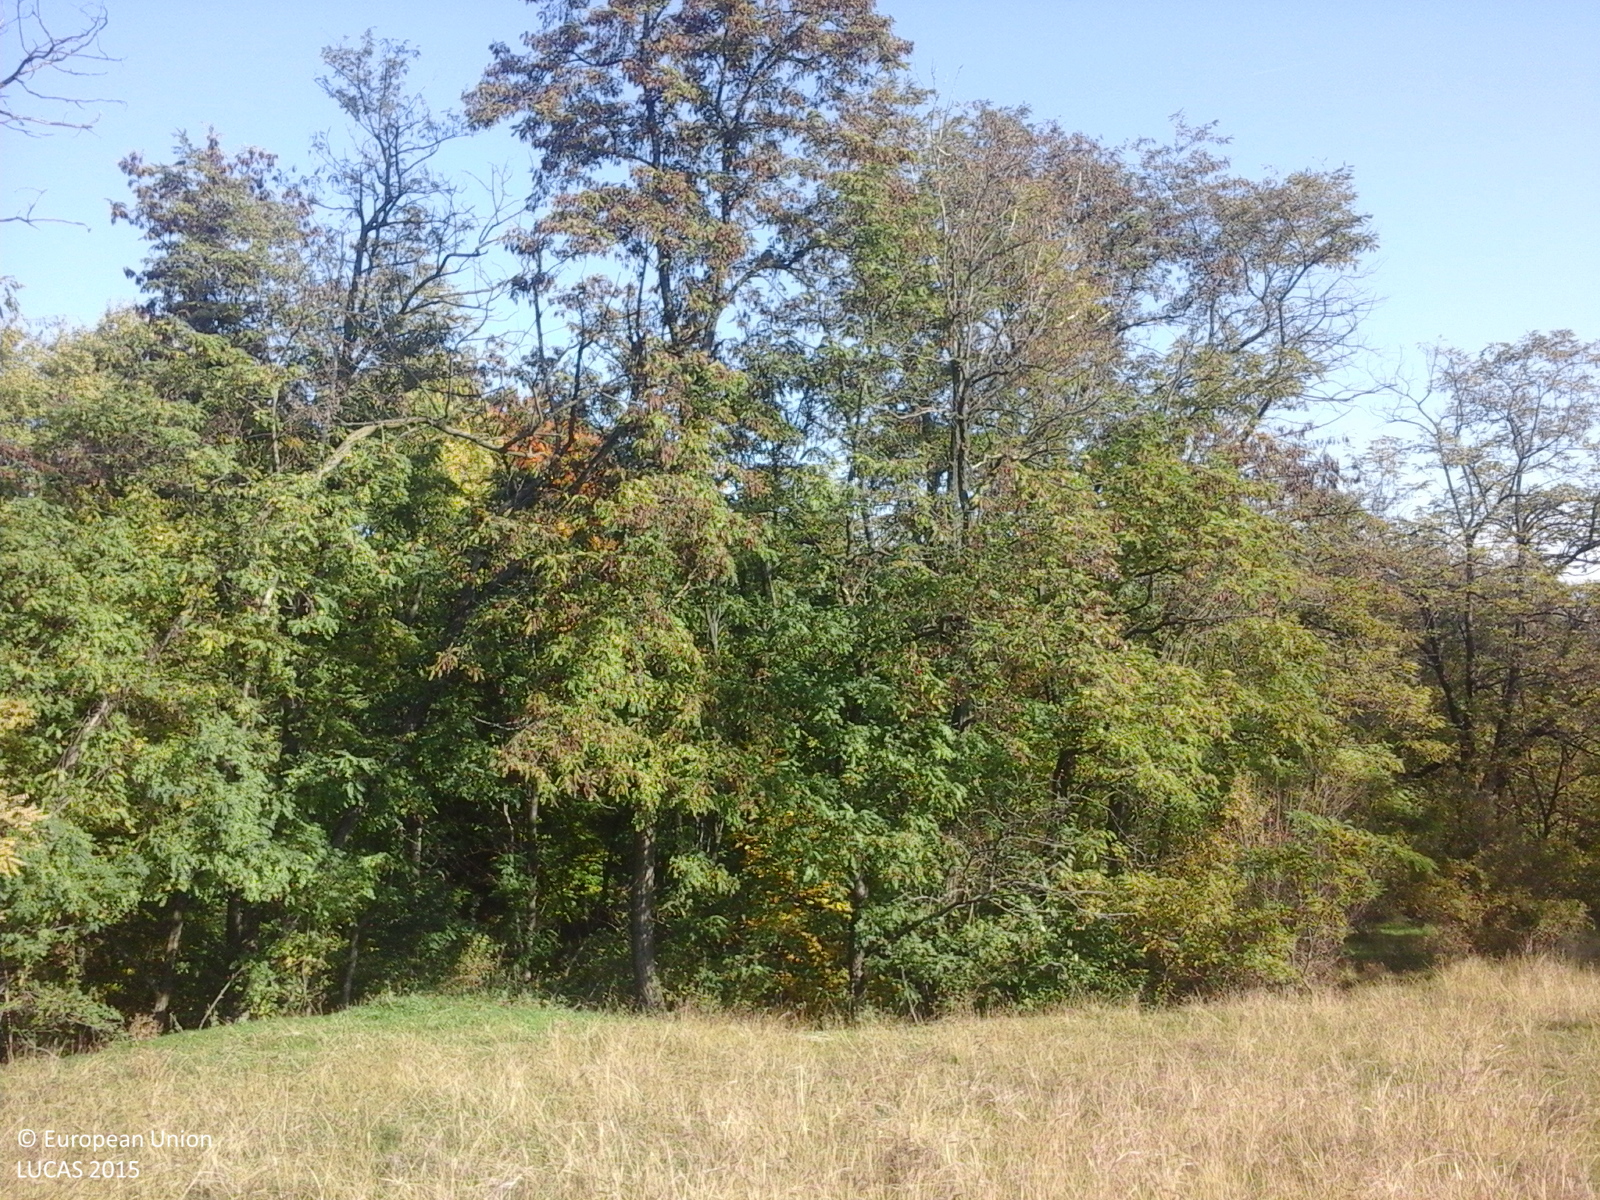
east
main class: Grassland
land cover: Grassland without tree/shrub cover
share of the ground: > 75 %
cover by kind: herbaceous plants 100 %
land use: Agriculture (excluding fallow land and kitchen gardens)
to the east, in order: Grassland without tree/shrub cover; Broadleaved woodland; Vineyards; Grassland without tree/shrub cover; Abandoned hedges; Fences; Tracks; Spontaneously vegetated surfaces; Grassland without tree/shrub cover
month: October
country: RO
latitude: 46.0912
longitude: 27.0503
